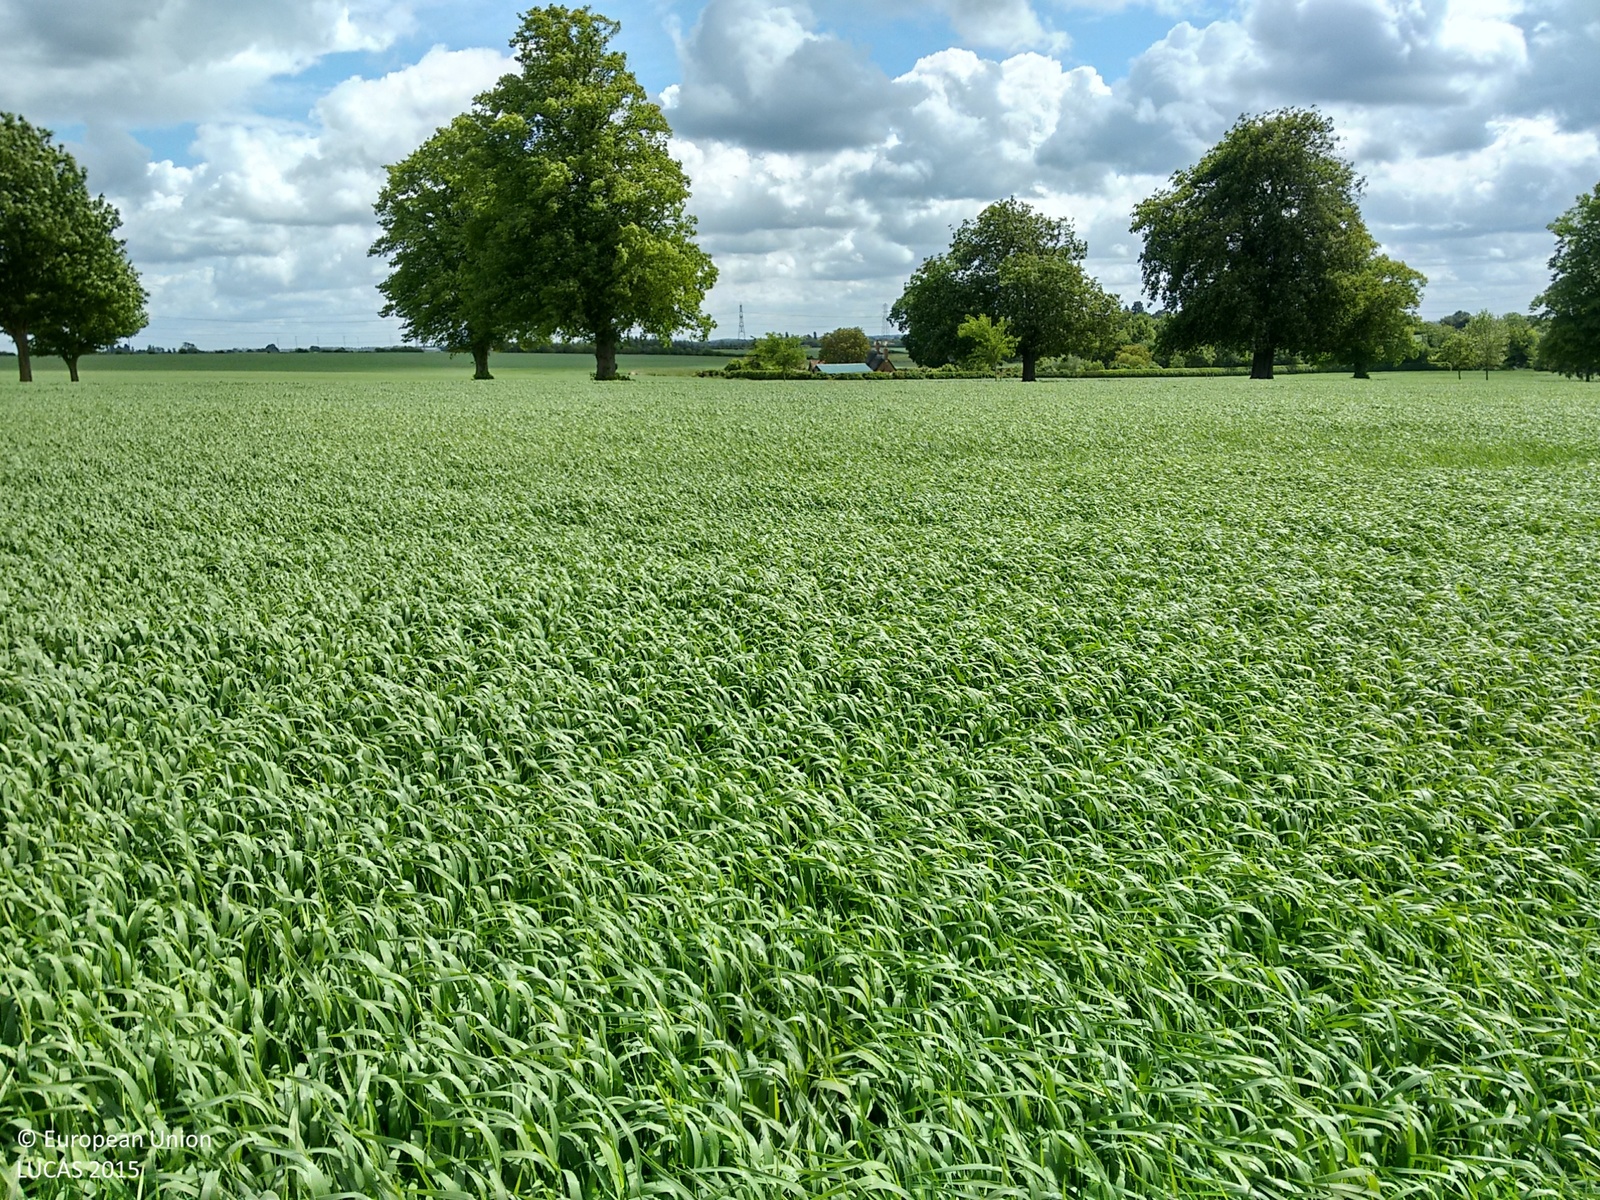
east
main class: Cropland
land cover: Barley
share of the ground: > 75 %
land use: Agriculture (excluding fallow land and kitchen gardens)
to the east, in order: Barley; Grassland with sparse tree/shrub cover; Paved roads, cycling and walking lanes; Grassland with sparse tree/shrub cover; Barley; Managed hedges; Artificial constructions in urban areas; Managed hedges; Grassland without tree/shrub cover
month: June
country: GB
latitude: 52.2338
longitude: -0.3298
